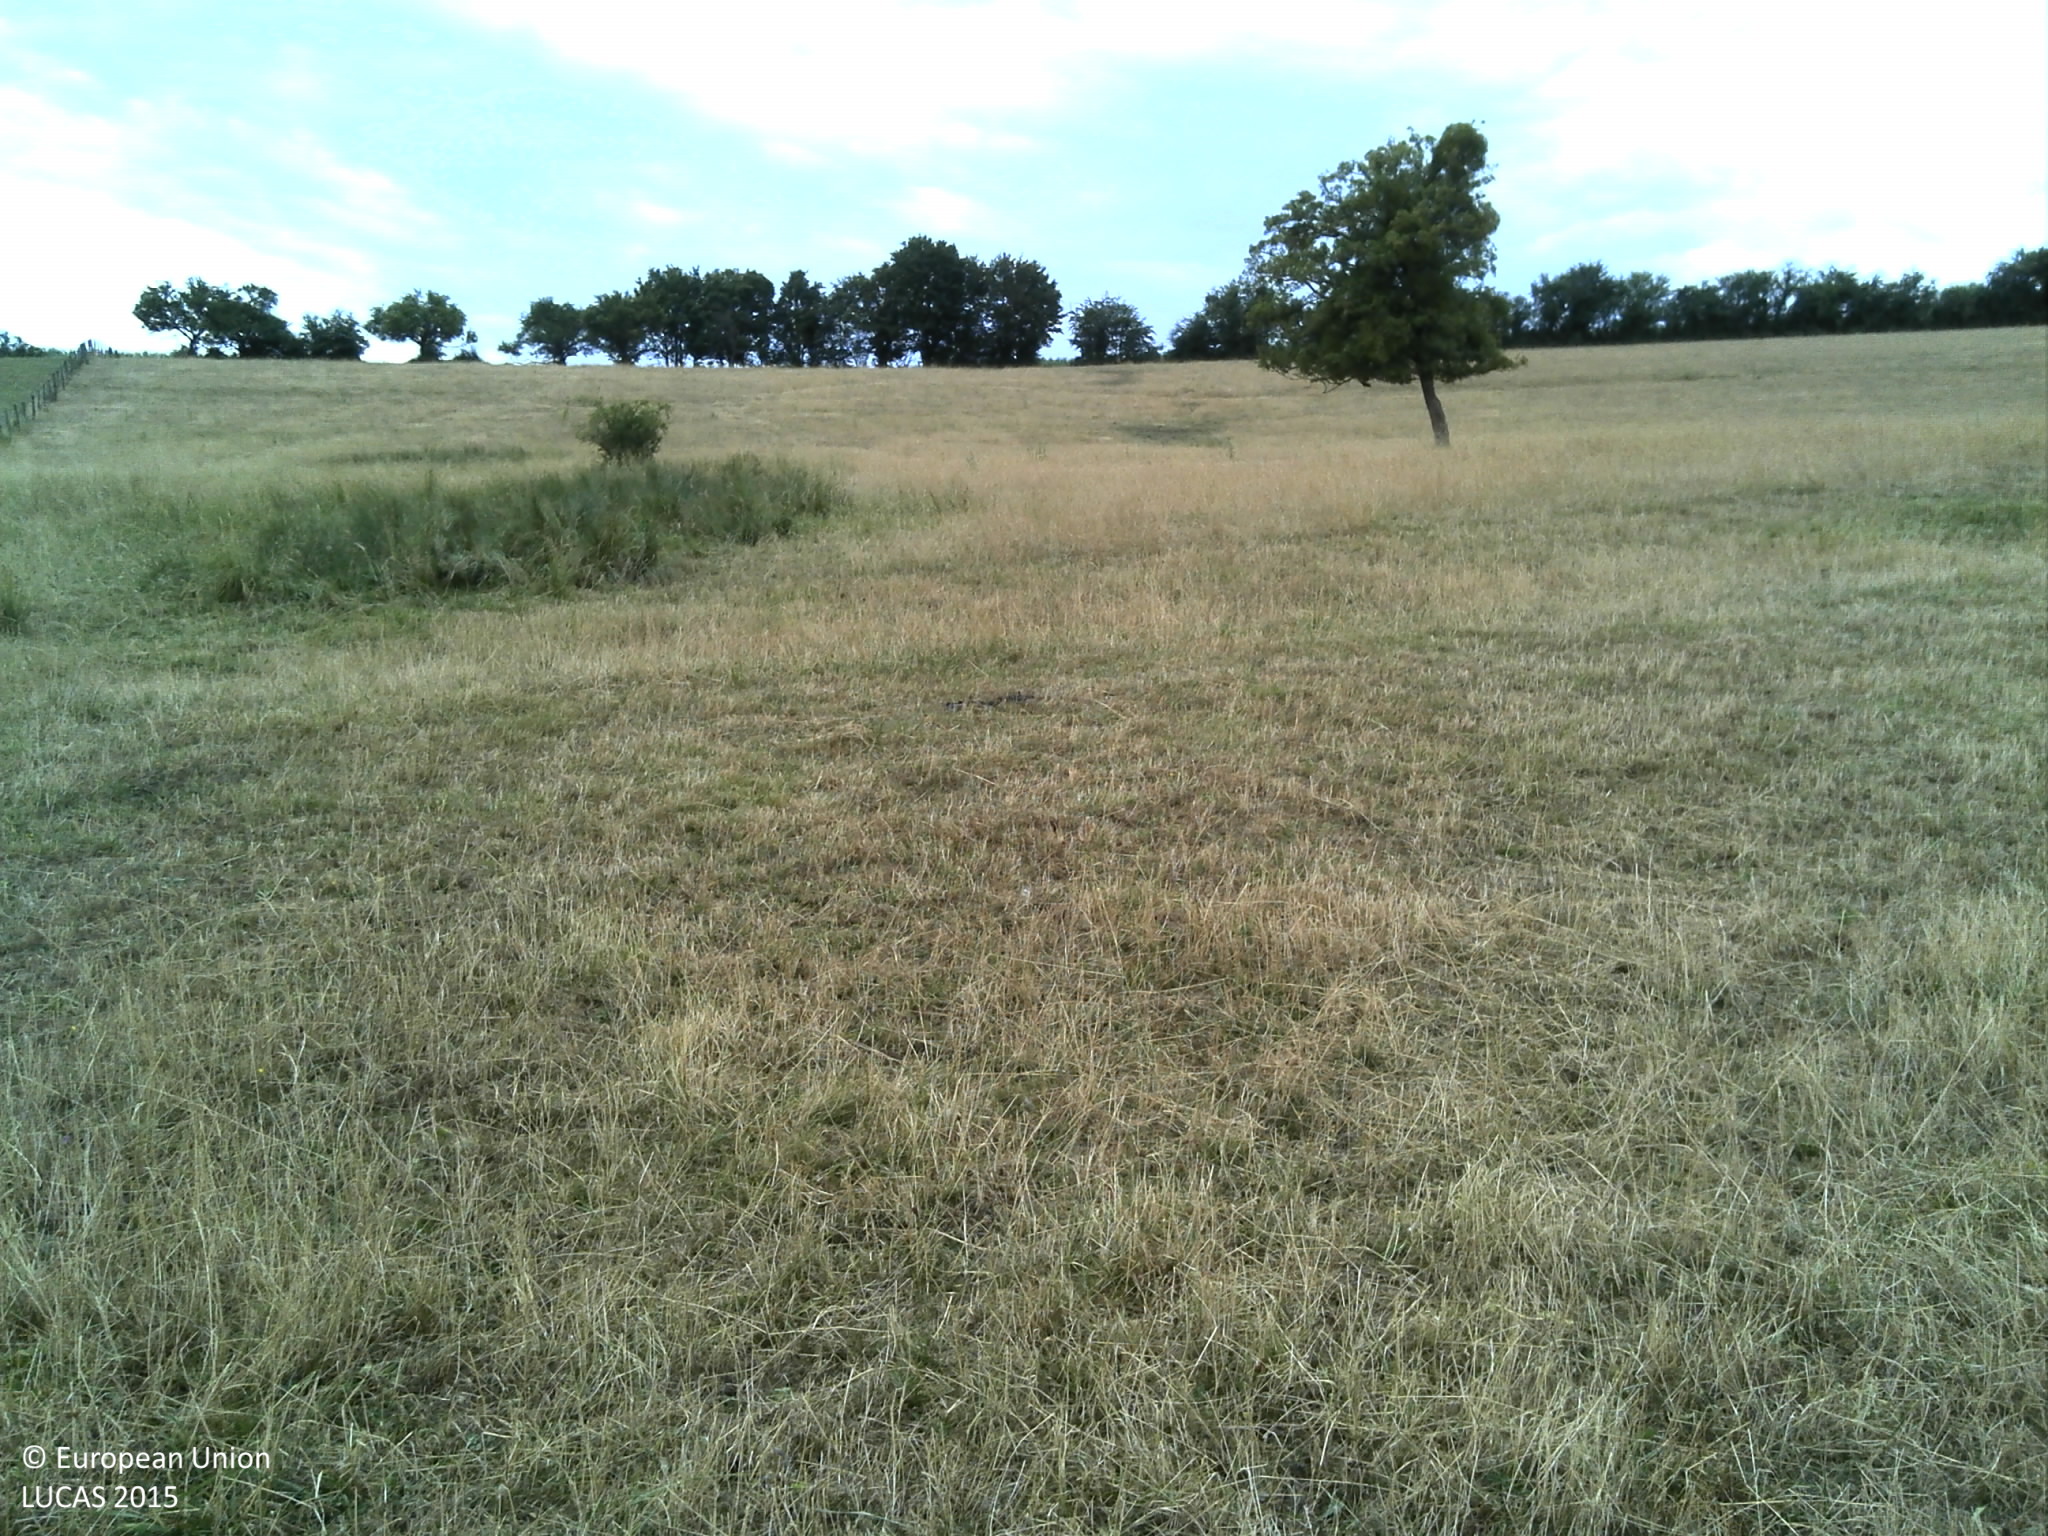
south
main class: Grassland
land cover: Grassland without tree/shrub cover
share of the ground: > 75 %
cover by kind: herbaceous plants 100 %
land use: Agriculture (excluding fallow land and kitchen gardens)
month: July
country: FR
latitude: 48.3224
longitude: 6.2646
